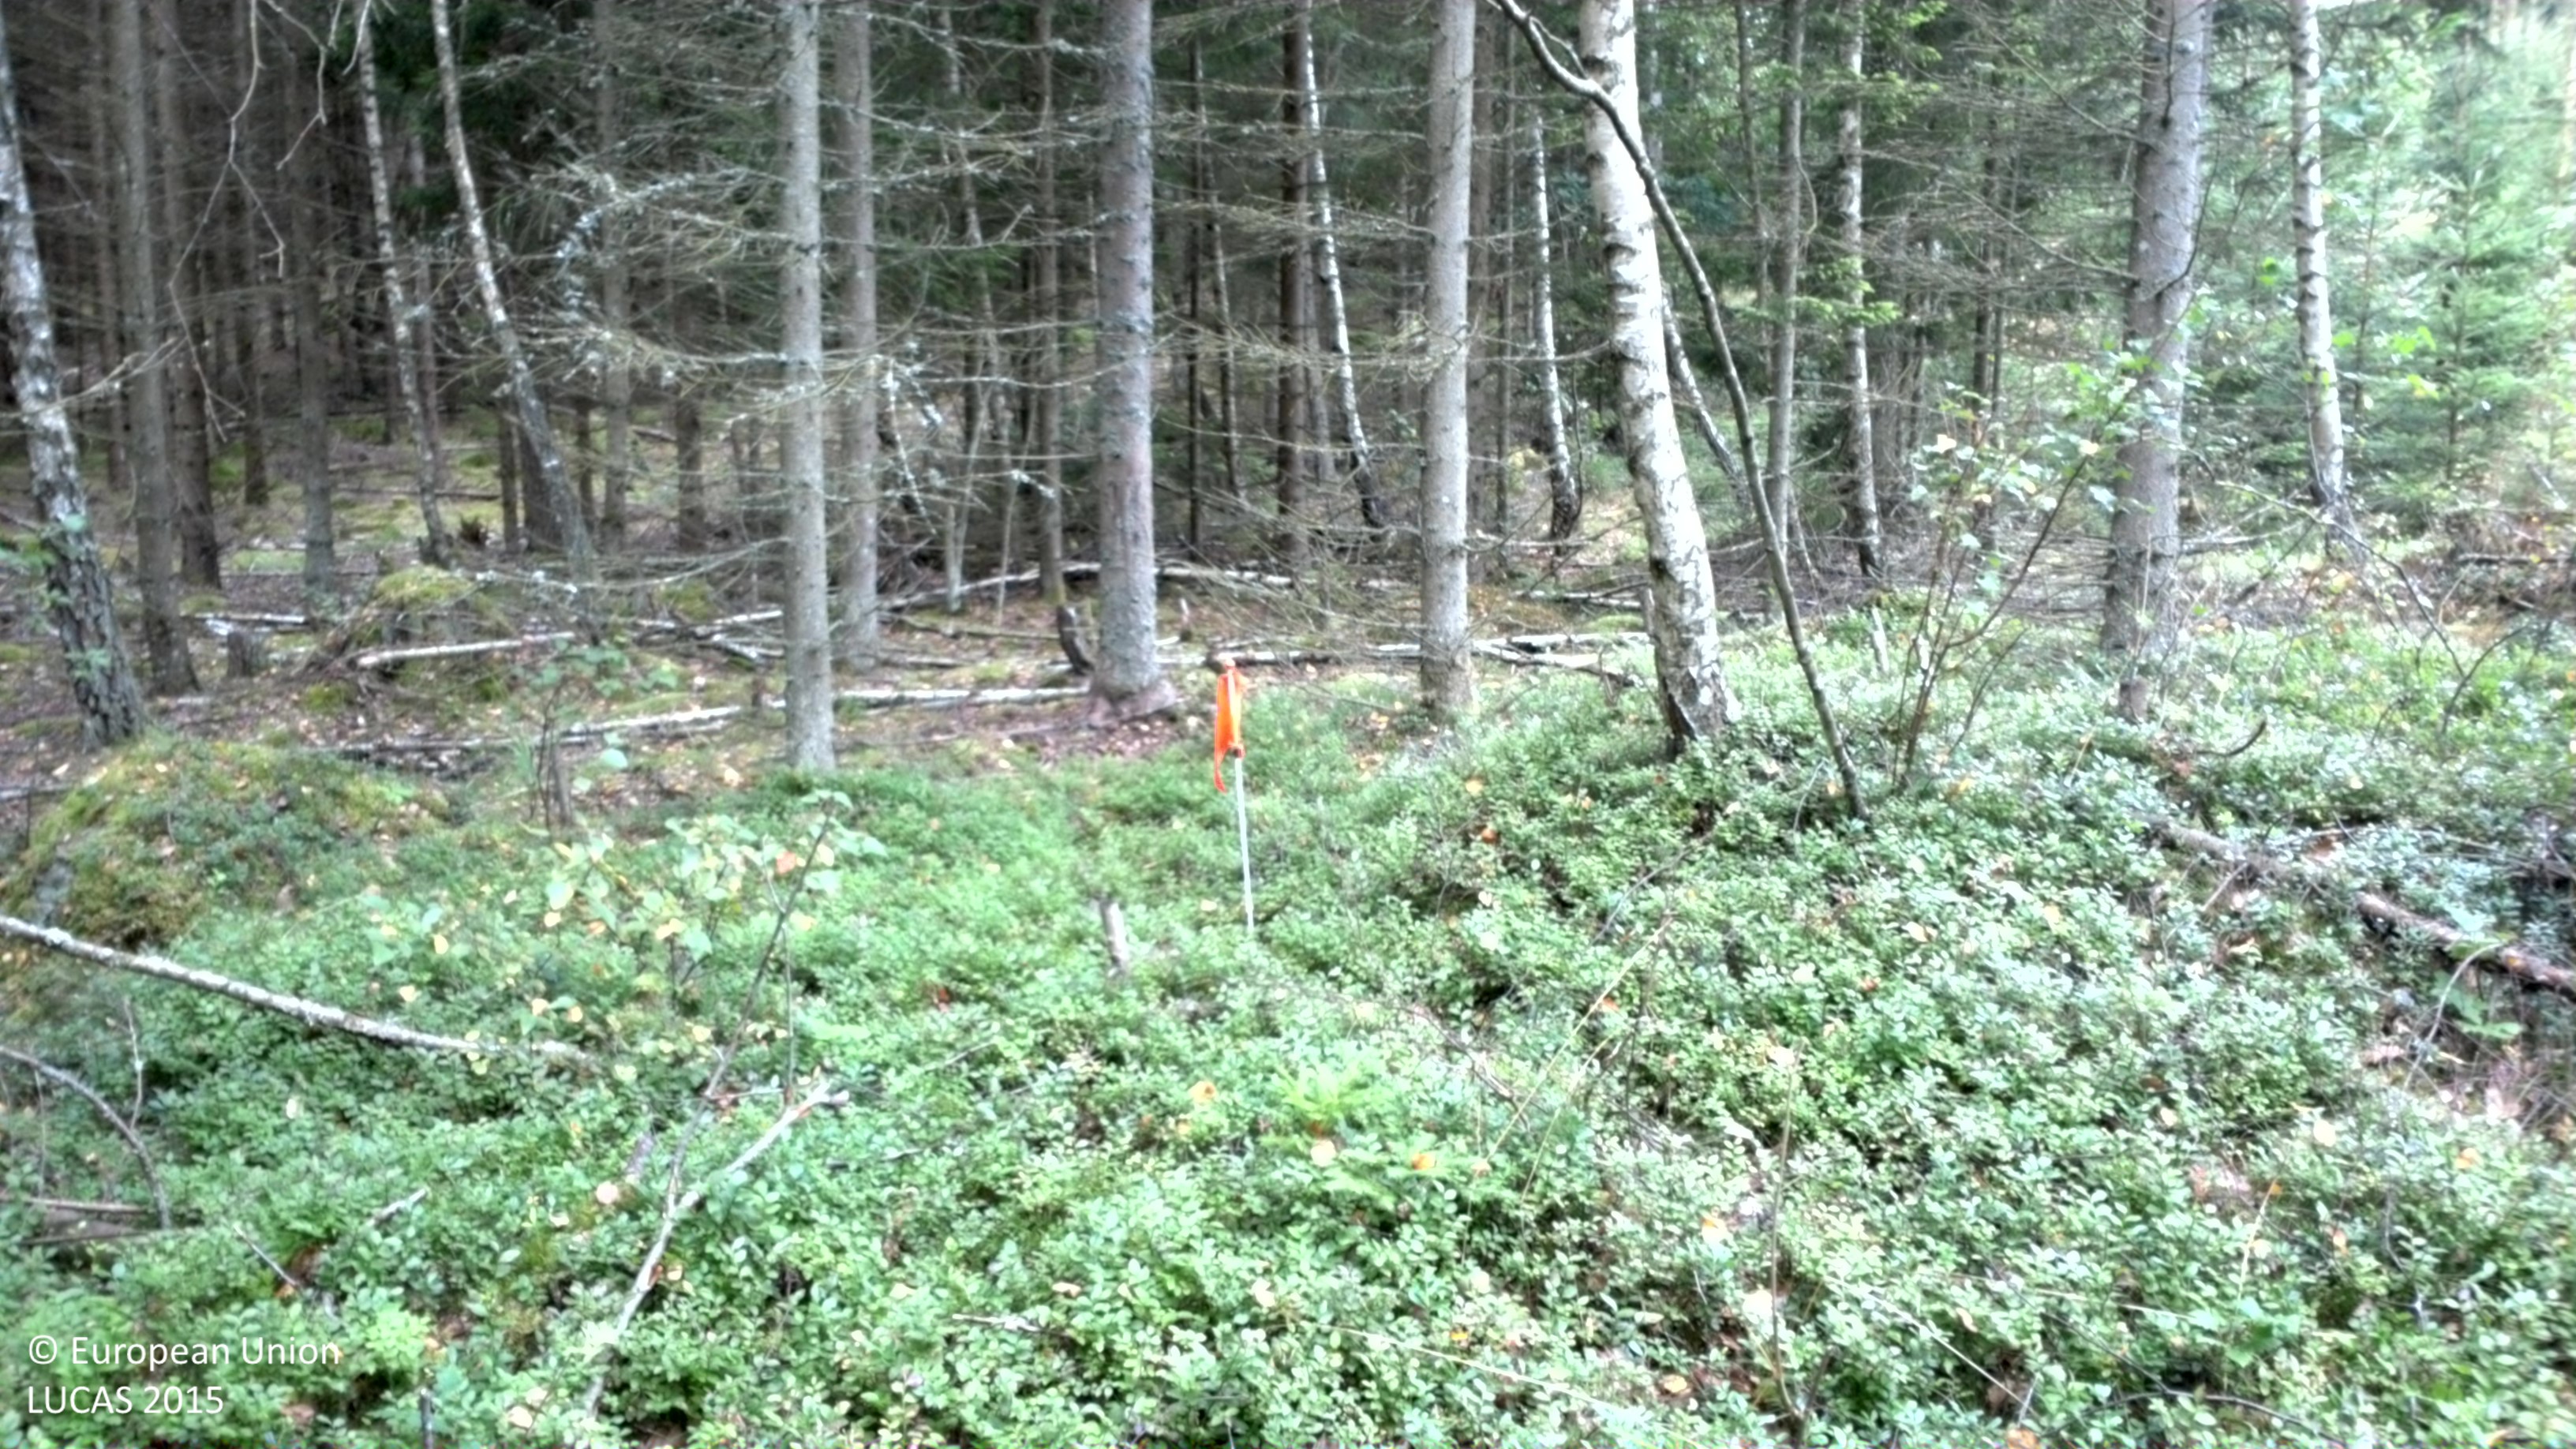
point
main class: Woodland
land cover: Spruce dominated mixed woodland
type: boreal forest
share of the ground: 50 - 75 %
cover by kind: coniferous forest trees 50 %, broadleaved forest trees 20 %, shrubs 15 %, lichens and mosses 15 %
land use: Forestry
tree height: > 5 m
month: August
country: SE
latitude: 56.3334
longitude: 14.2514
